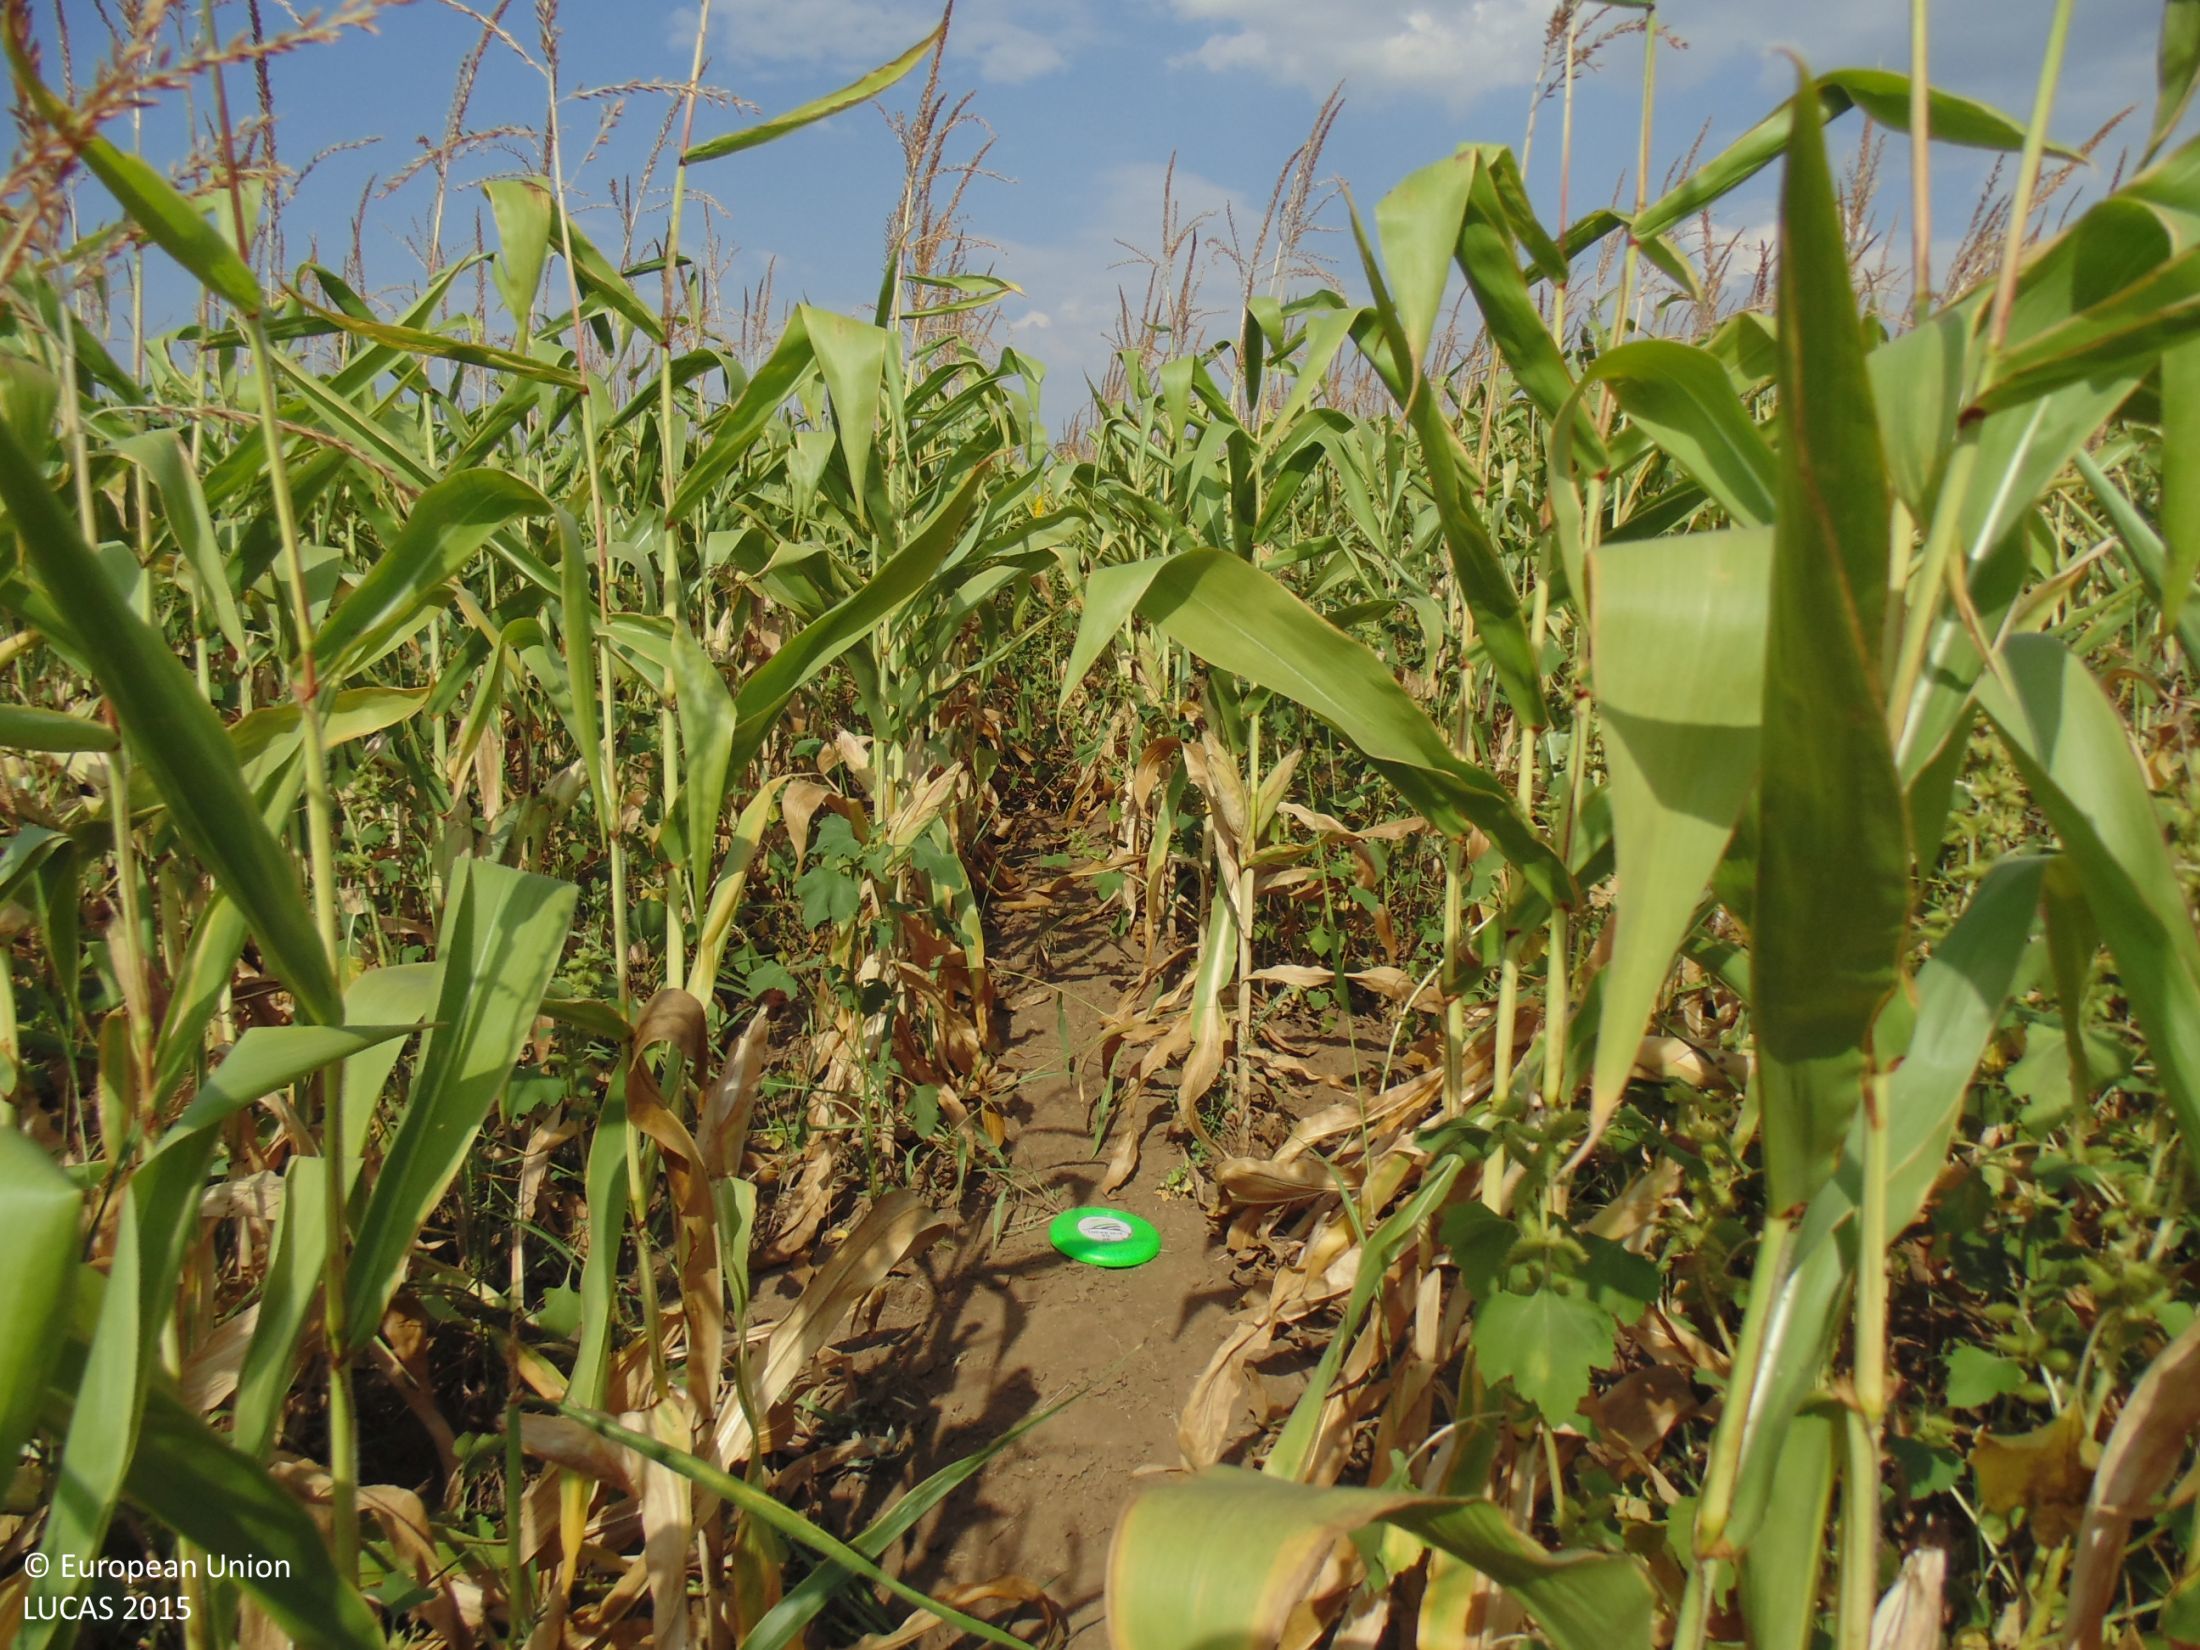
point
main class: Cropland
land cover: Maize
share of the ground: > 75 %
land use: Agriculture (excluding fallow land and kitchen gardens)
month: August
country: BG
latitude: 43.8379
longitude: 27.5357
